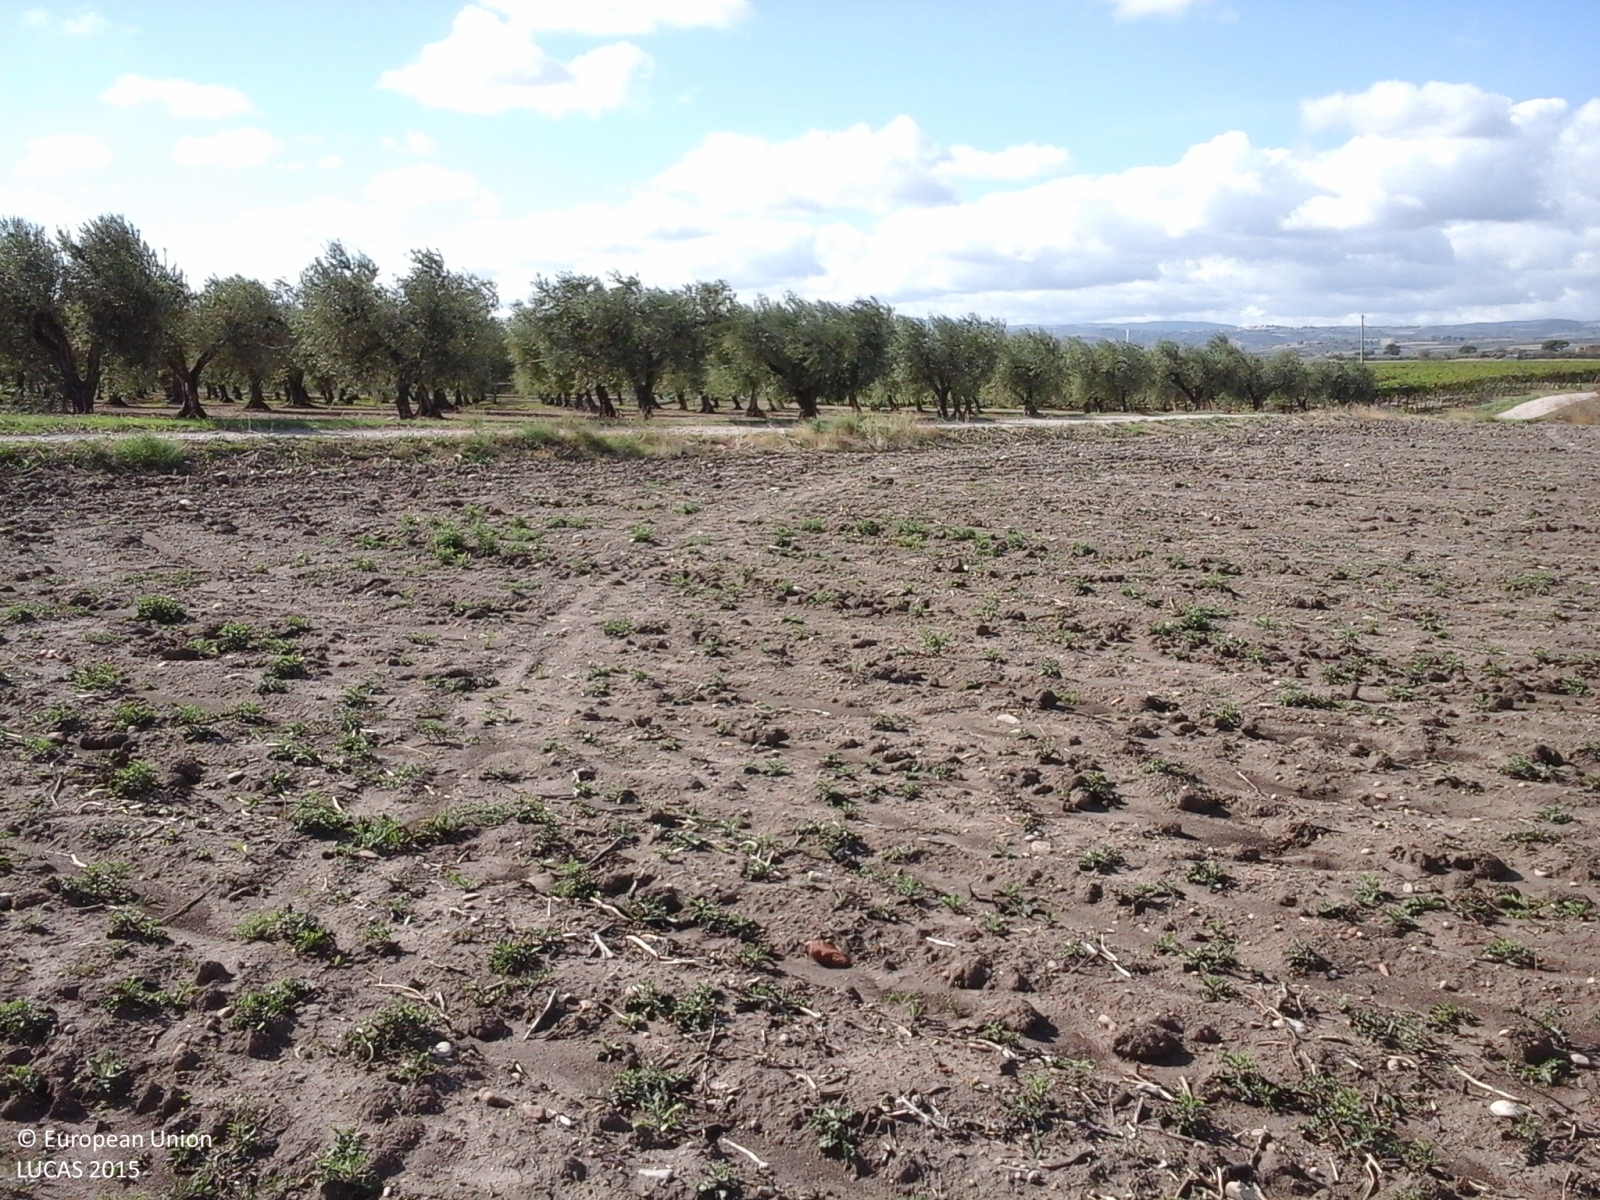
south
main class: Cropland
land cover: Dry pulses
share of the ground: > 75 %
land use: Agriculture (excluding fallow land and kitchen gardens)
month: September
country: IT
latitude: 41.6898
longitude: 15.1617
